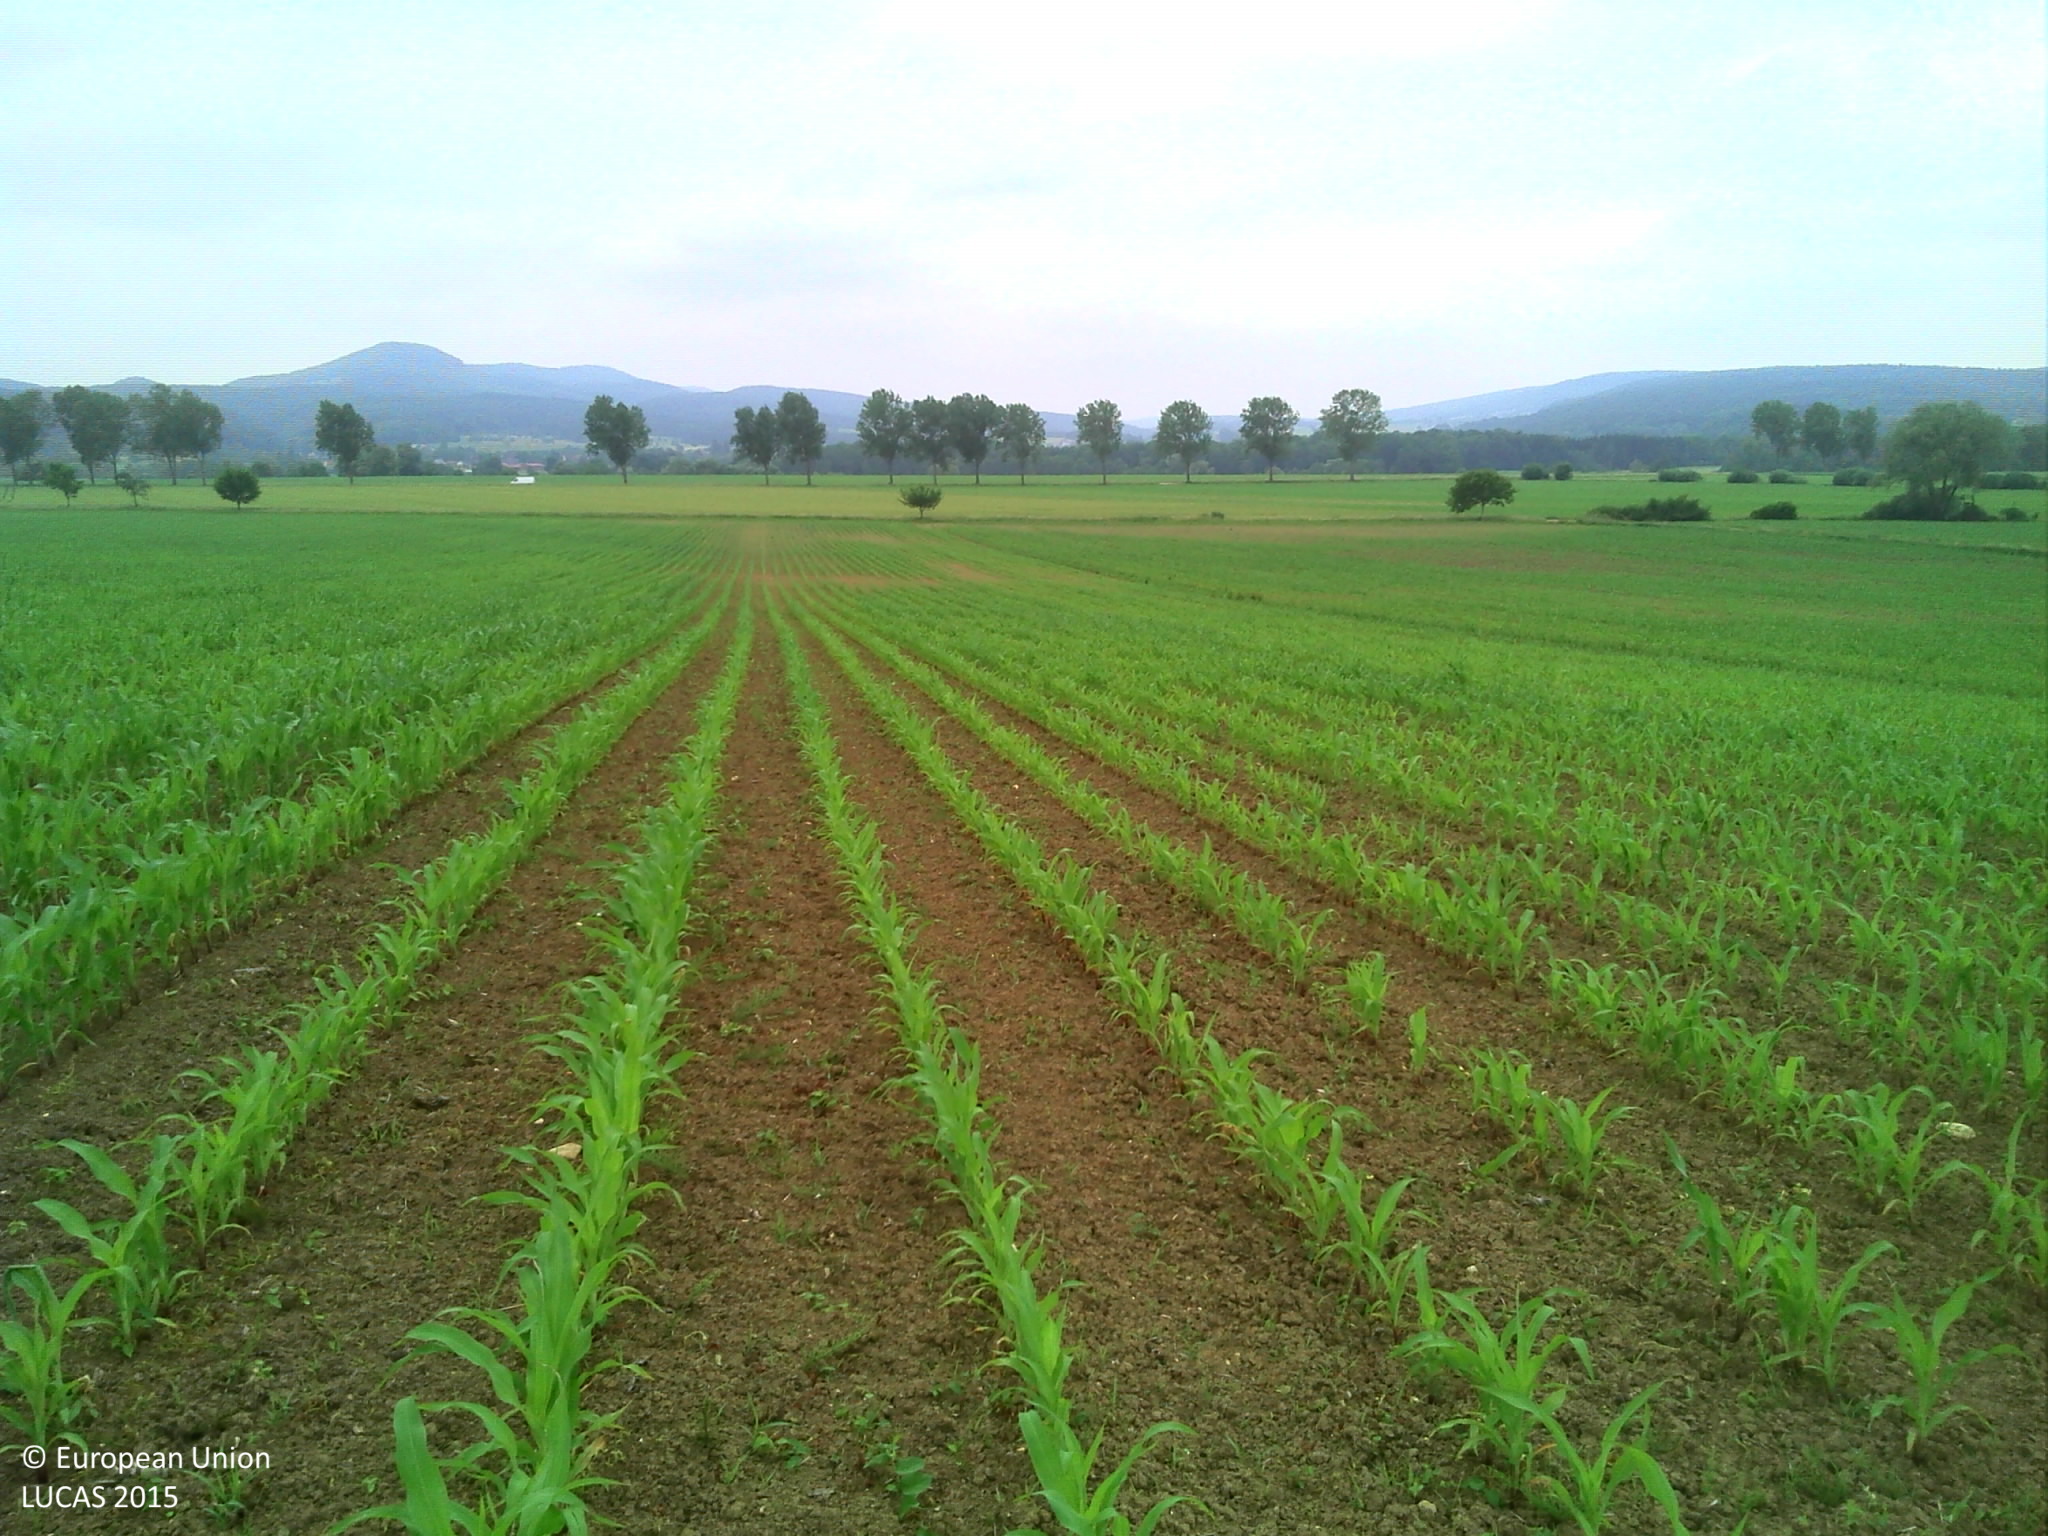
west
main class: Cropland
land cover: Maize
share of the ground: 10 - 25 %
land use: Agriculture (excluding fallow land and kitchen gardens)
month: June
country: FR
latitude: 47.4730
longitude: 7.4144
